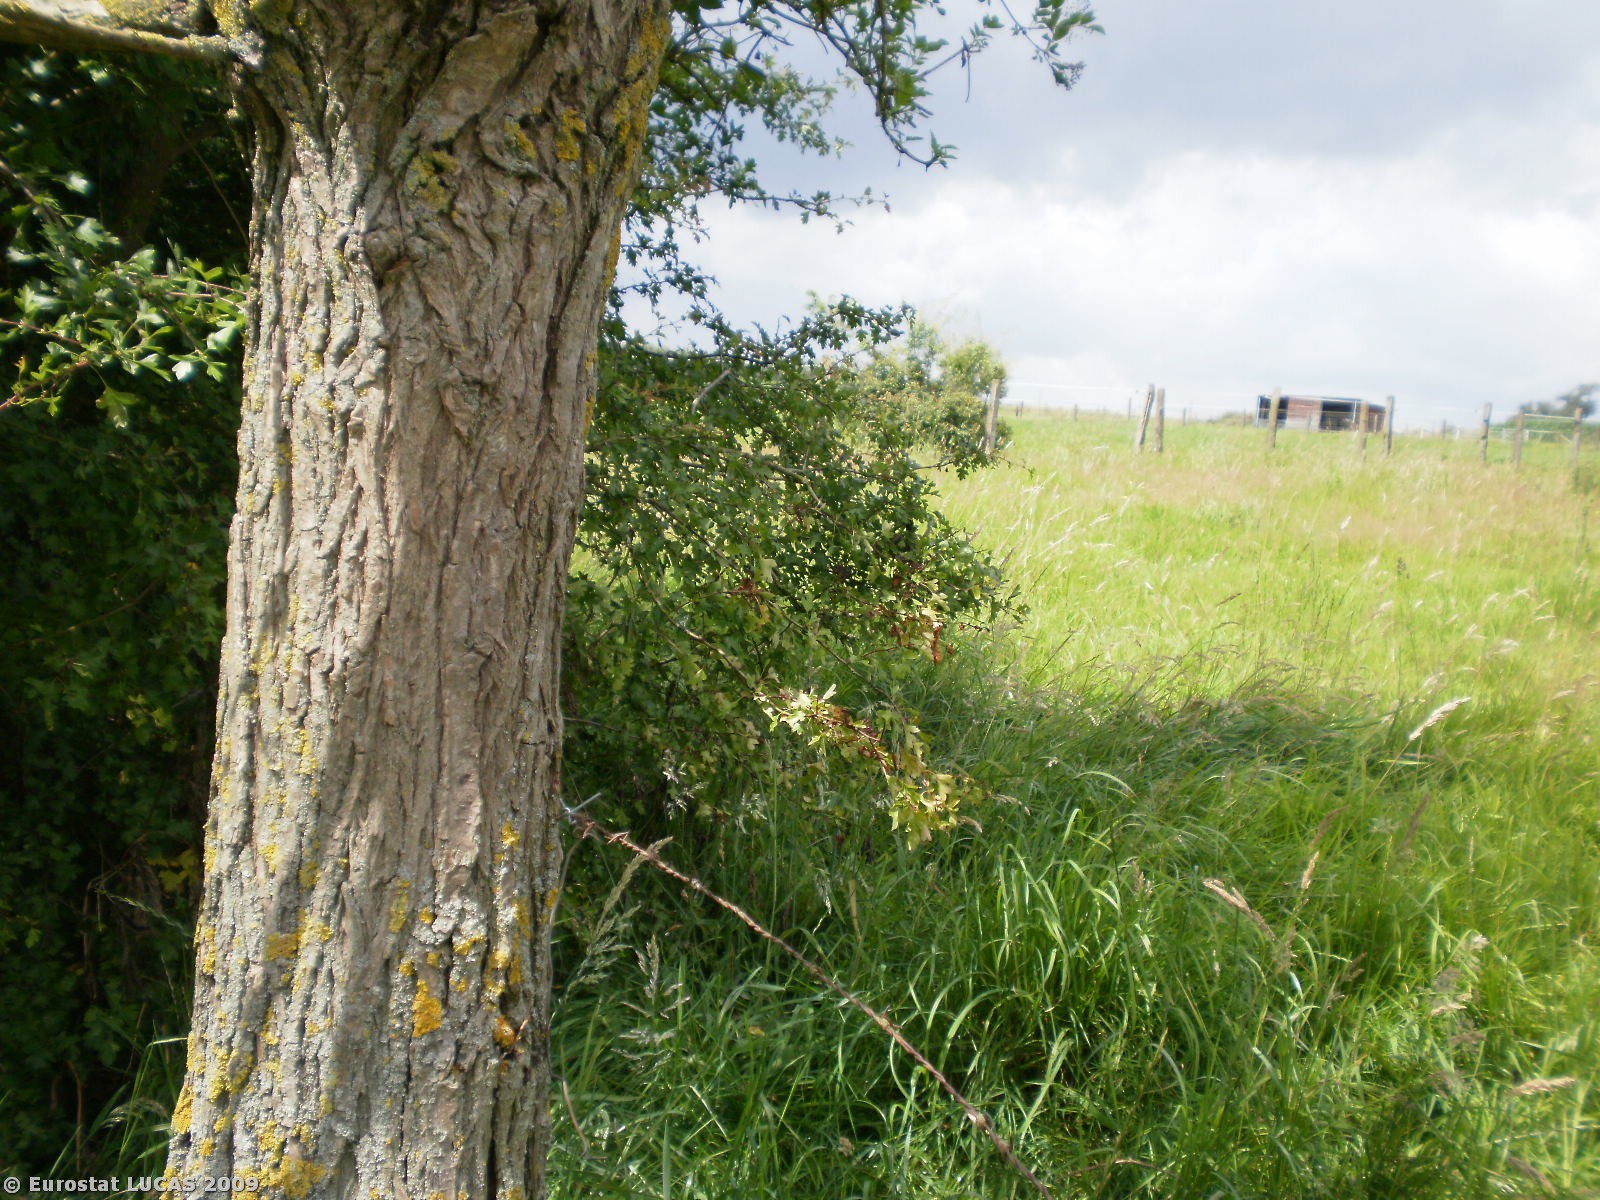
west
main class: Grassland
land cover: Grassland without tree/shrub cover
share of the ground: > 75 %
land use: Agriculture (excluding fallow land and kitchen gardens)
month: July
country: BE
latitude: 50.8041
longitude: 4.0488
